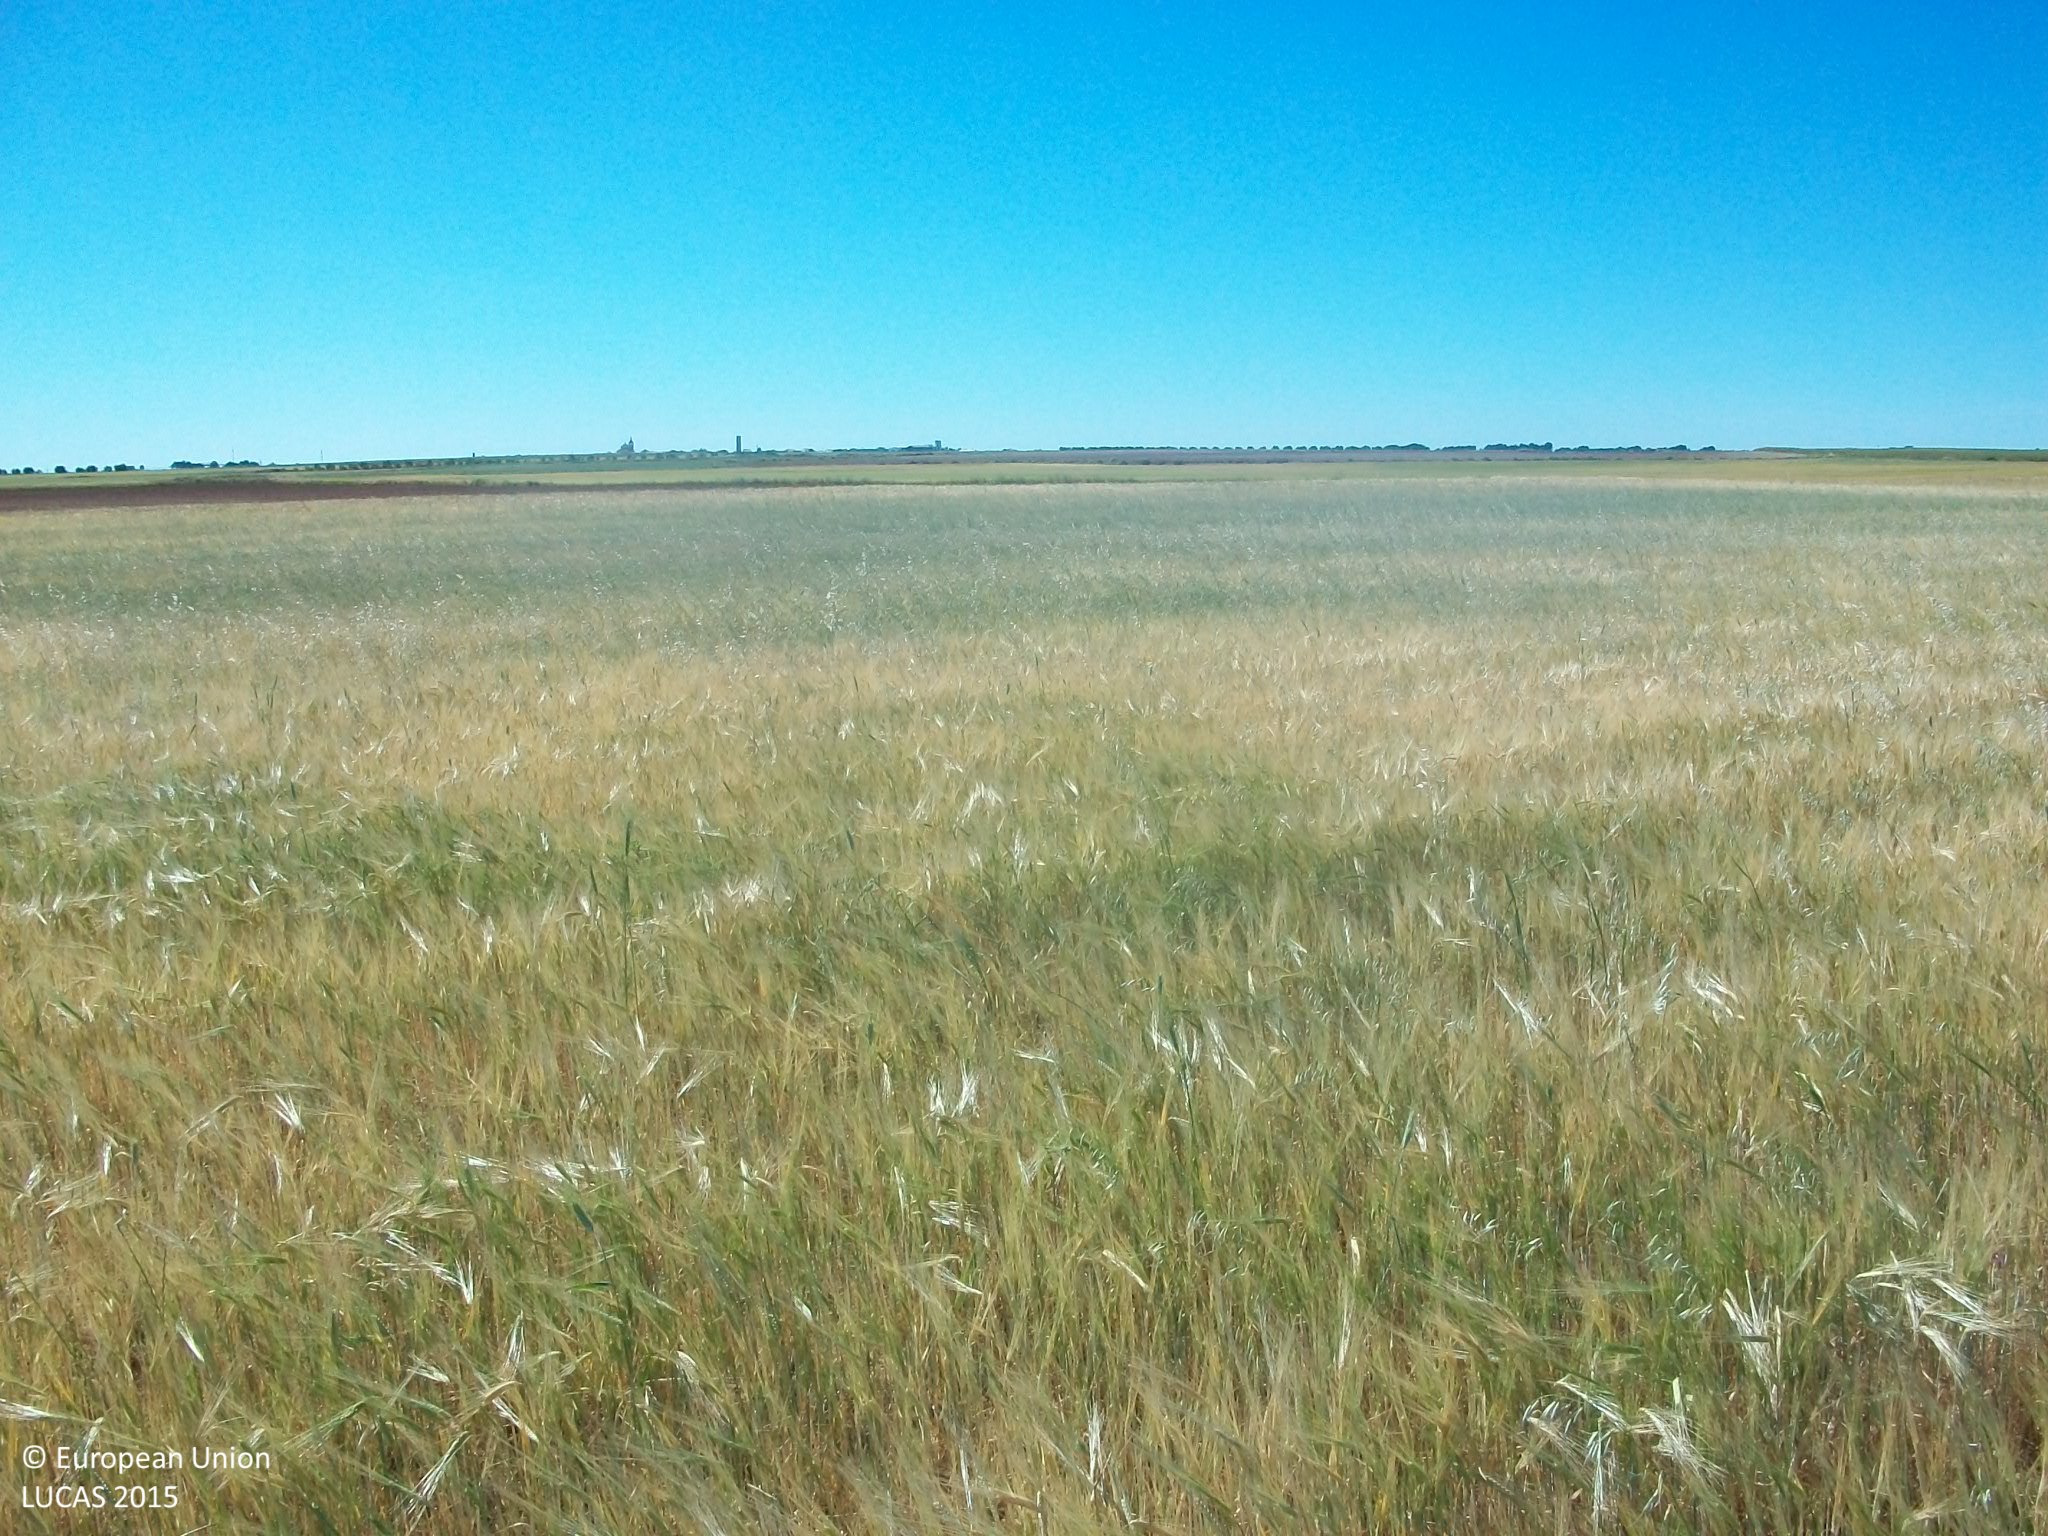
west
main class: Cropland
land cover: Barley
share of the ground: > 75 %
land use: Agriculture (excluding fallow land and kitchen gardens)
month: May
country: ES
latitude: 39.7774
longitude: -3.4409
